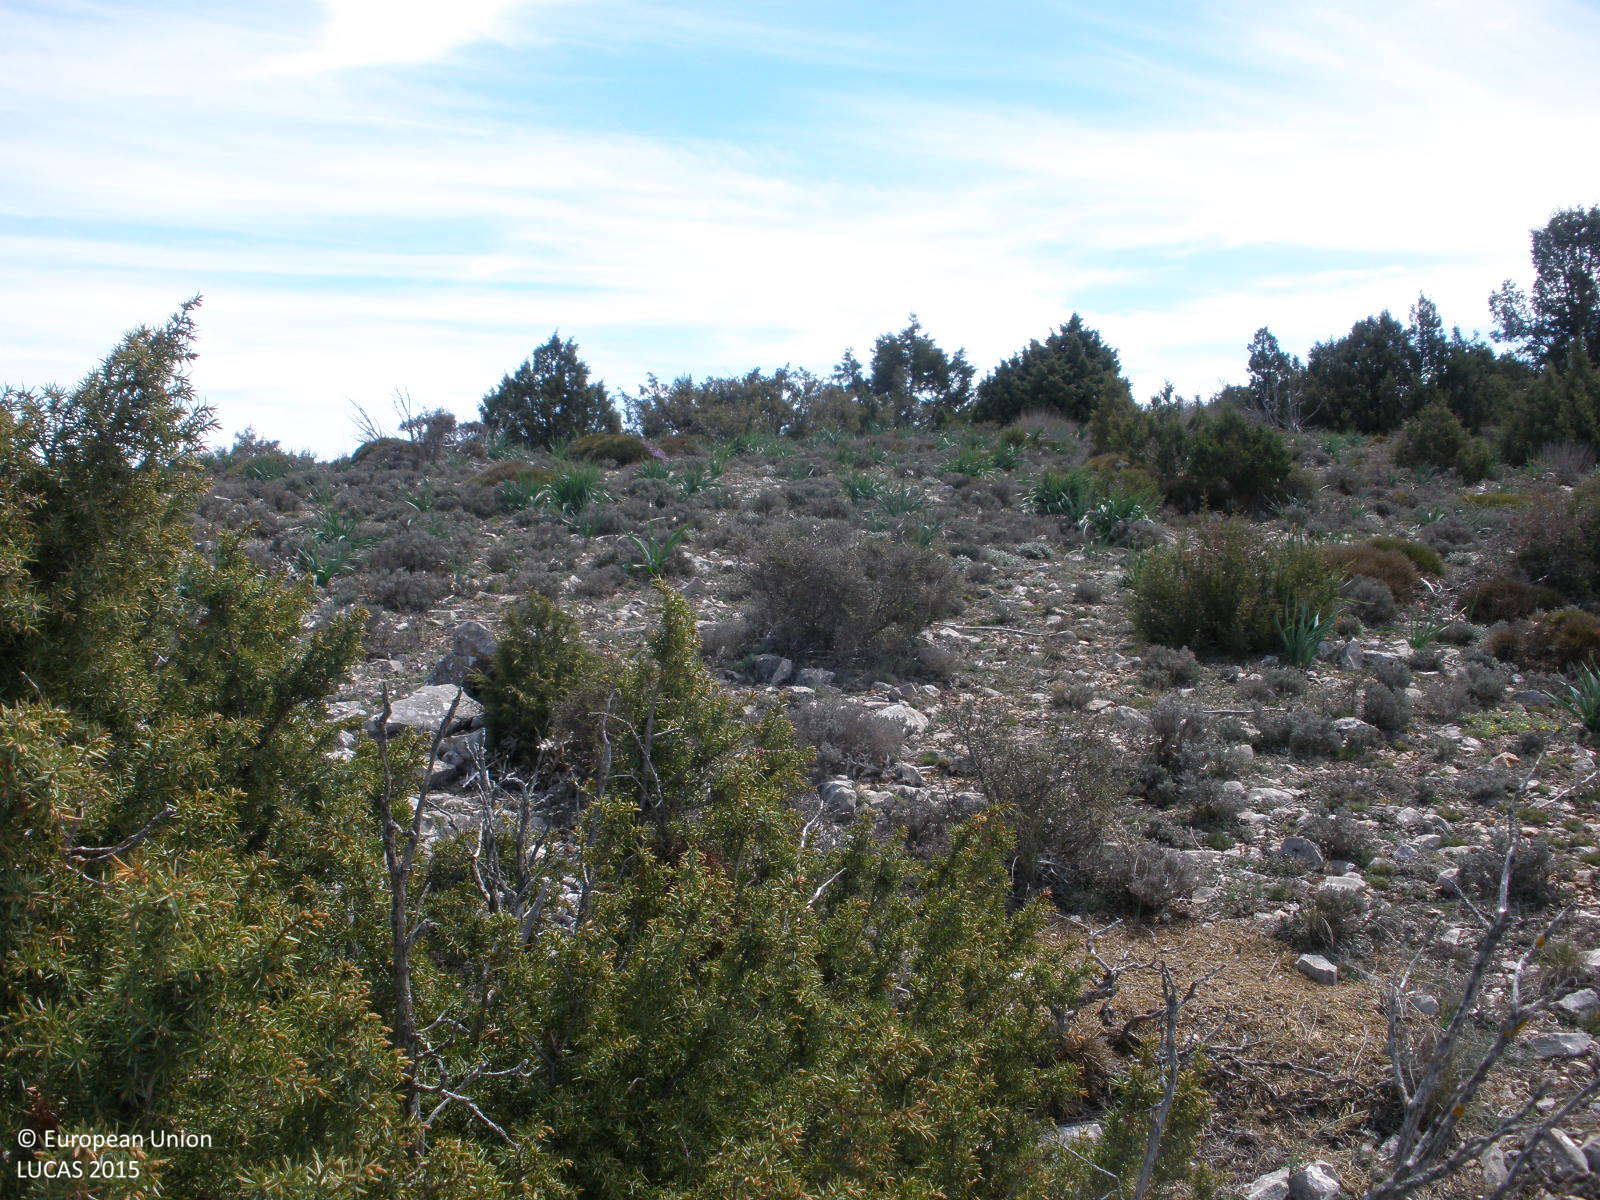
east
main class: Woodland
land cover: Other coniferous woodland
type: coniferous forest of the mediterranean region
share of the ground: 10 - 25 %
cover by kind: consolidated bare surface 45 %, shrubs 20 %, herbaceous plants 20 %, coniferous forest trees 15 %
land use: Semi-natural and natural areas not in use
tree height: < 5 m
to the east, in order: Other coniferous woodland; Other mixed woodland
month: April
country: ES
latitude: 40.2256
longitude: -1.0441
